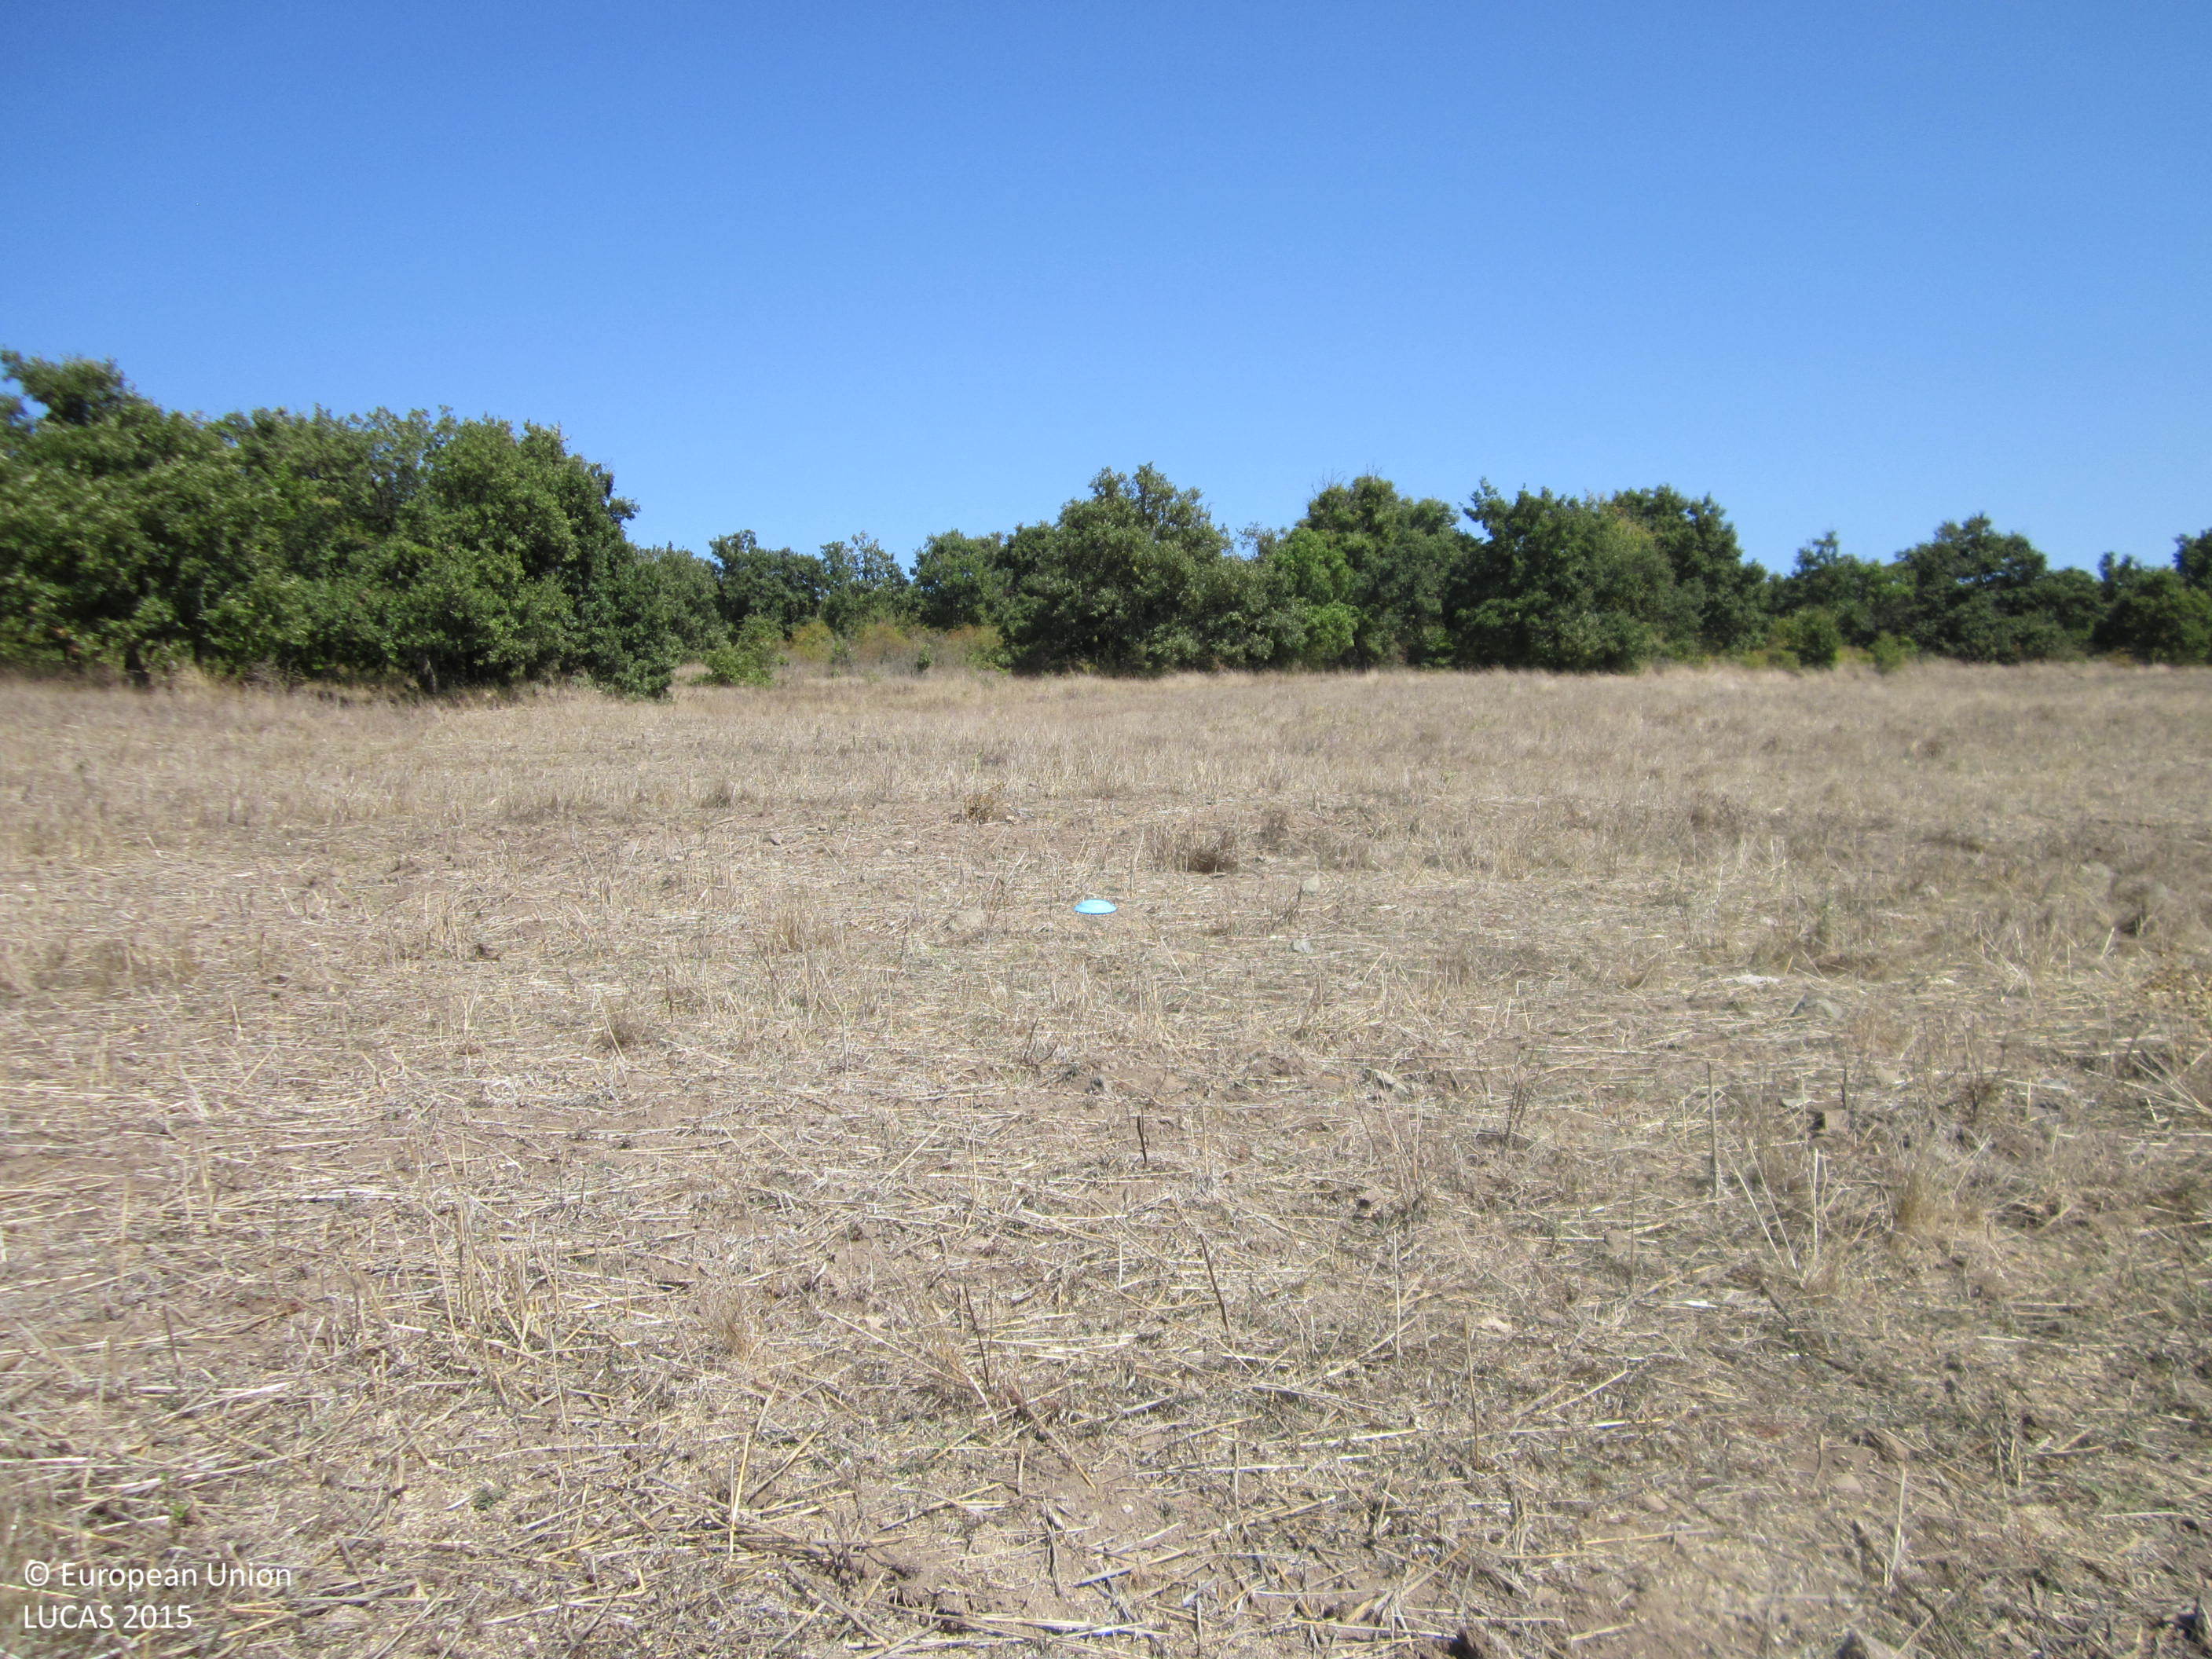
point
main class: Cropland
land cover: Common wheat
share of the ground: < 10 %
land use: Agriculture (excluding fallow land and kitchen gardens)
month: September
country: BG
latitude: 42.6980
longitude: 27.4157
